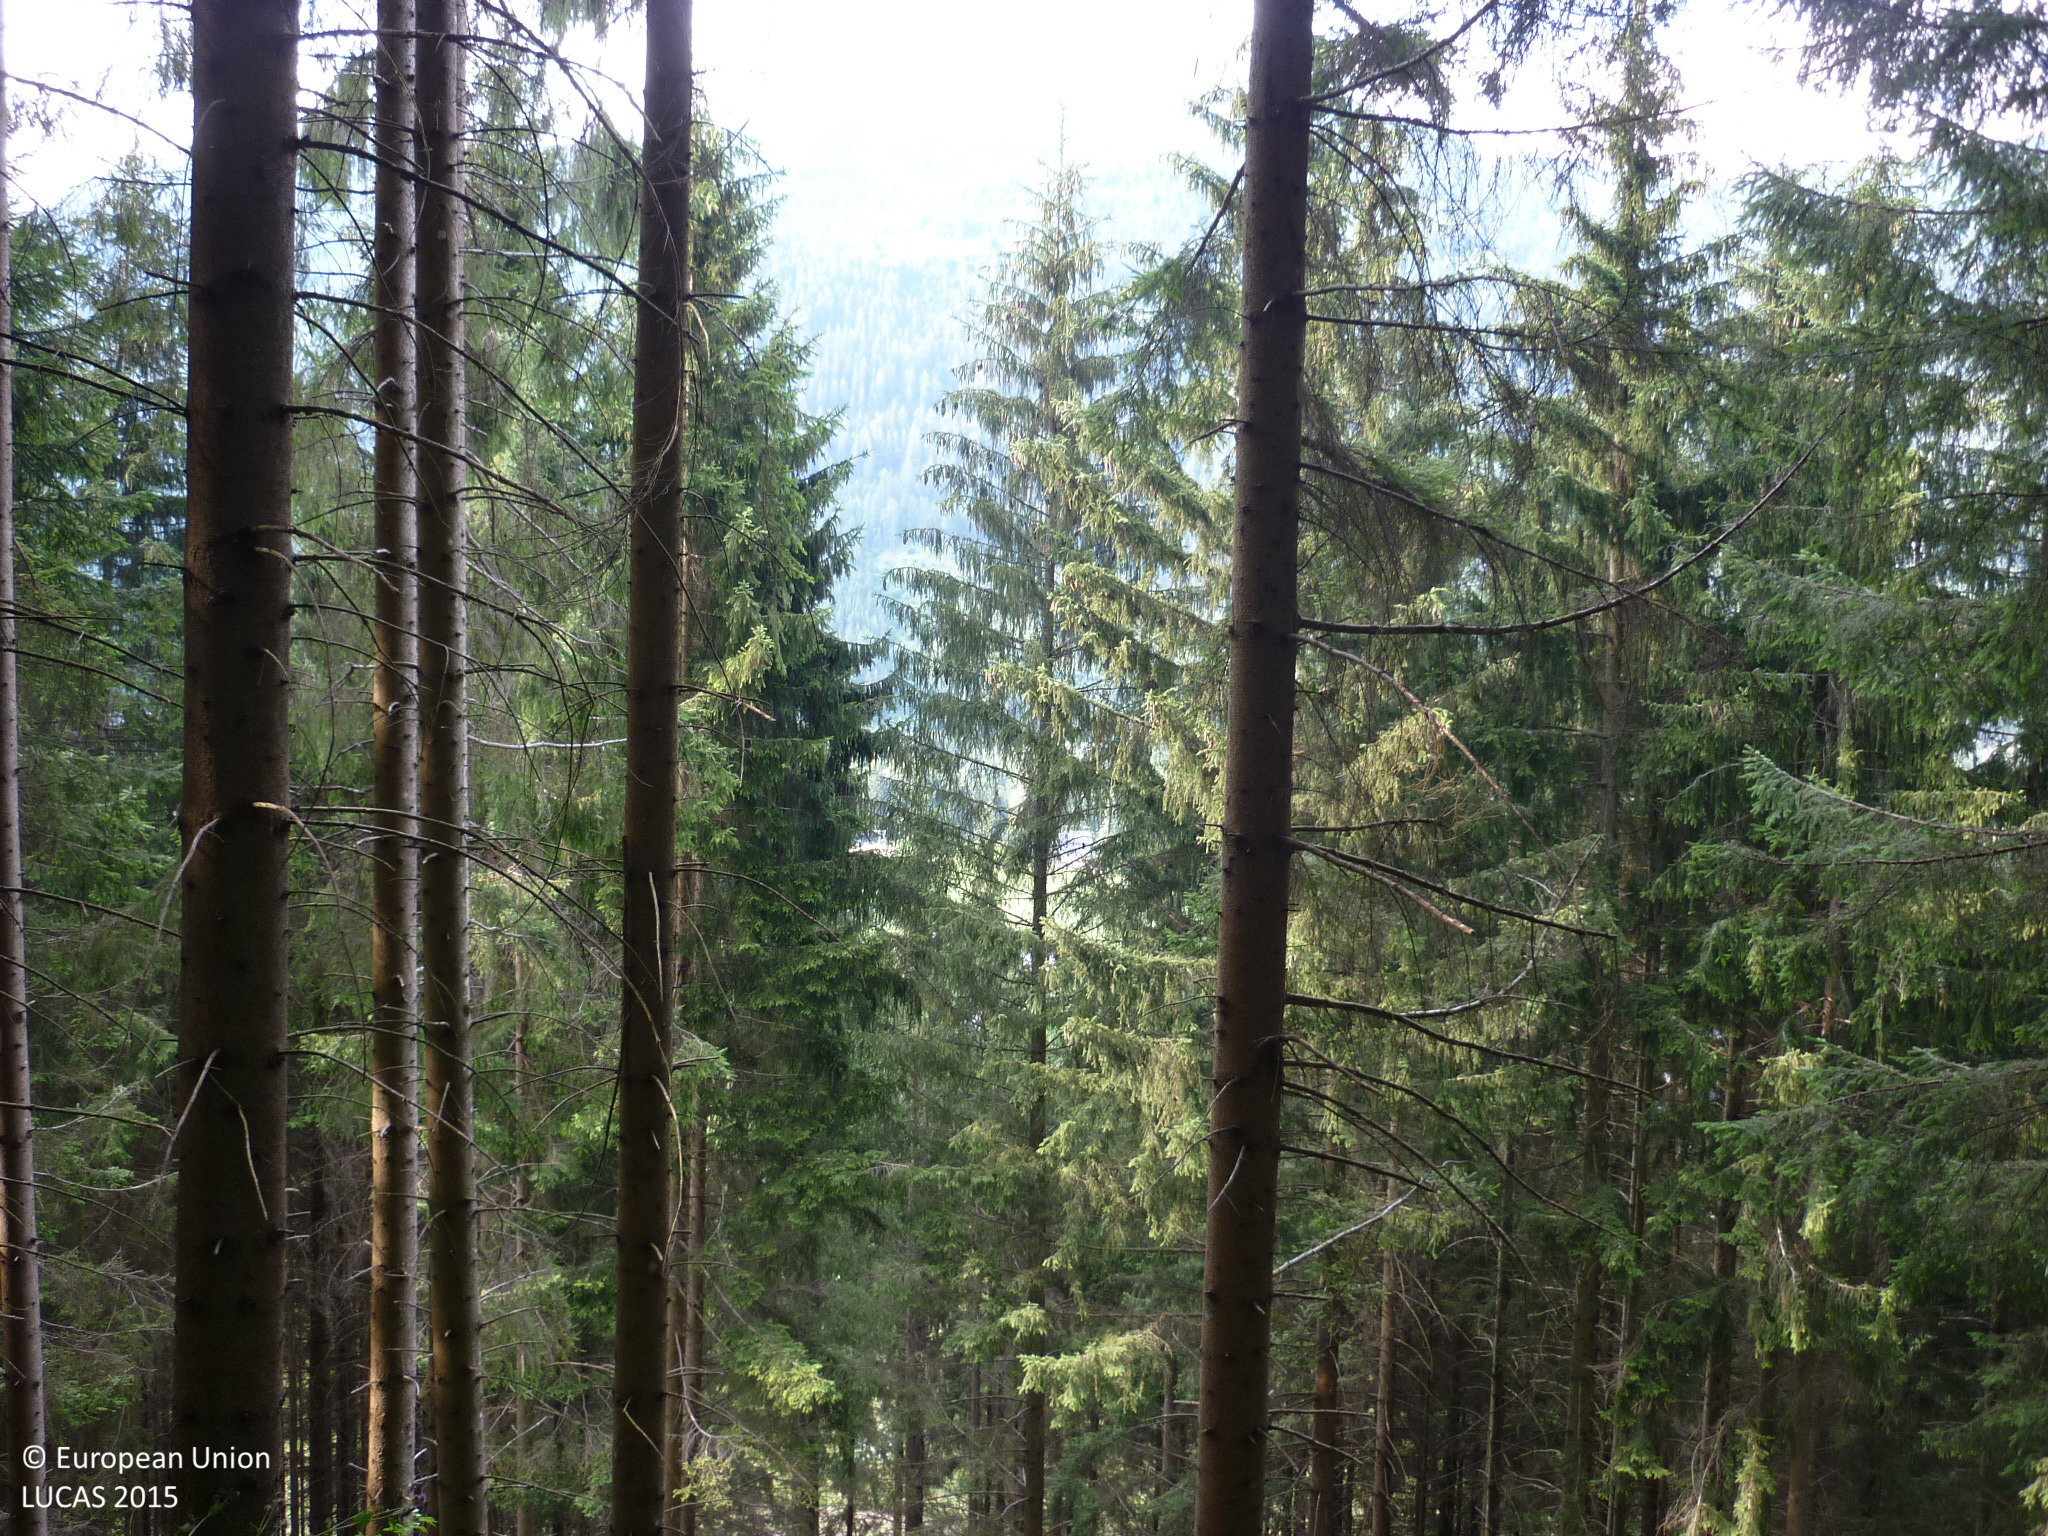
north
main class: Woodland
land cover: Spruce dominated coniferous woodland
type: alpine coniferous forest
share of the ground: > 75 %
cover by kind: coniferous forest trees 95 %, herbaceous plants 5 %
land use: Forestry
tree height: > 5 m
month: July
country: AT
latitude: 47.1300
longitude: 14.3092
